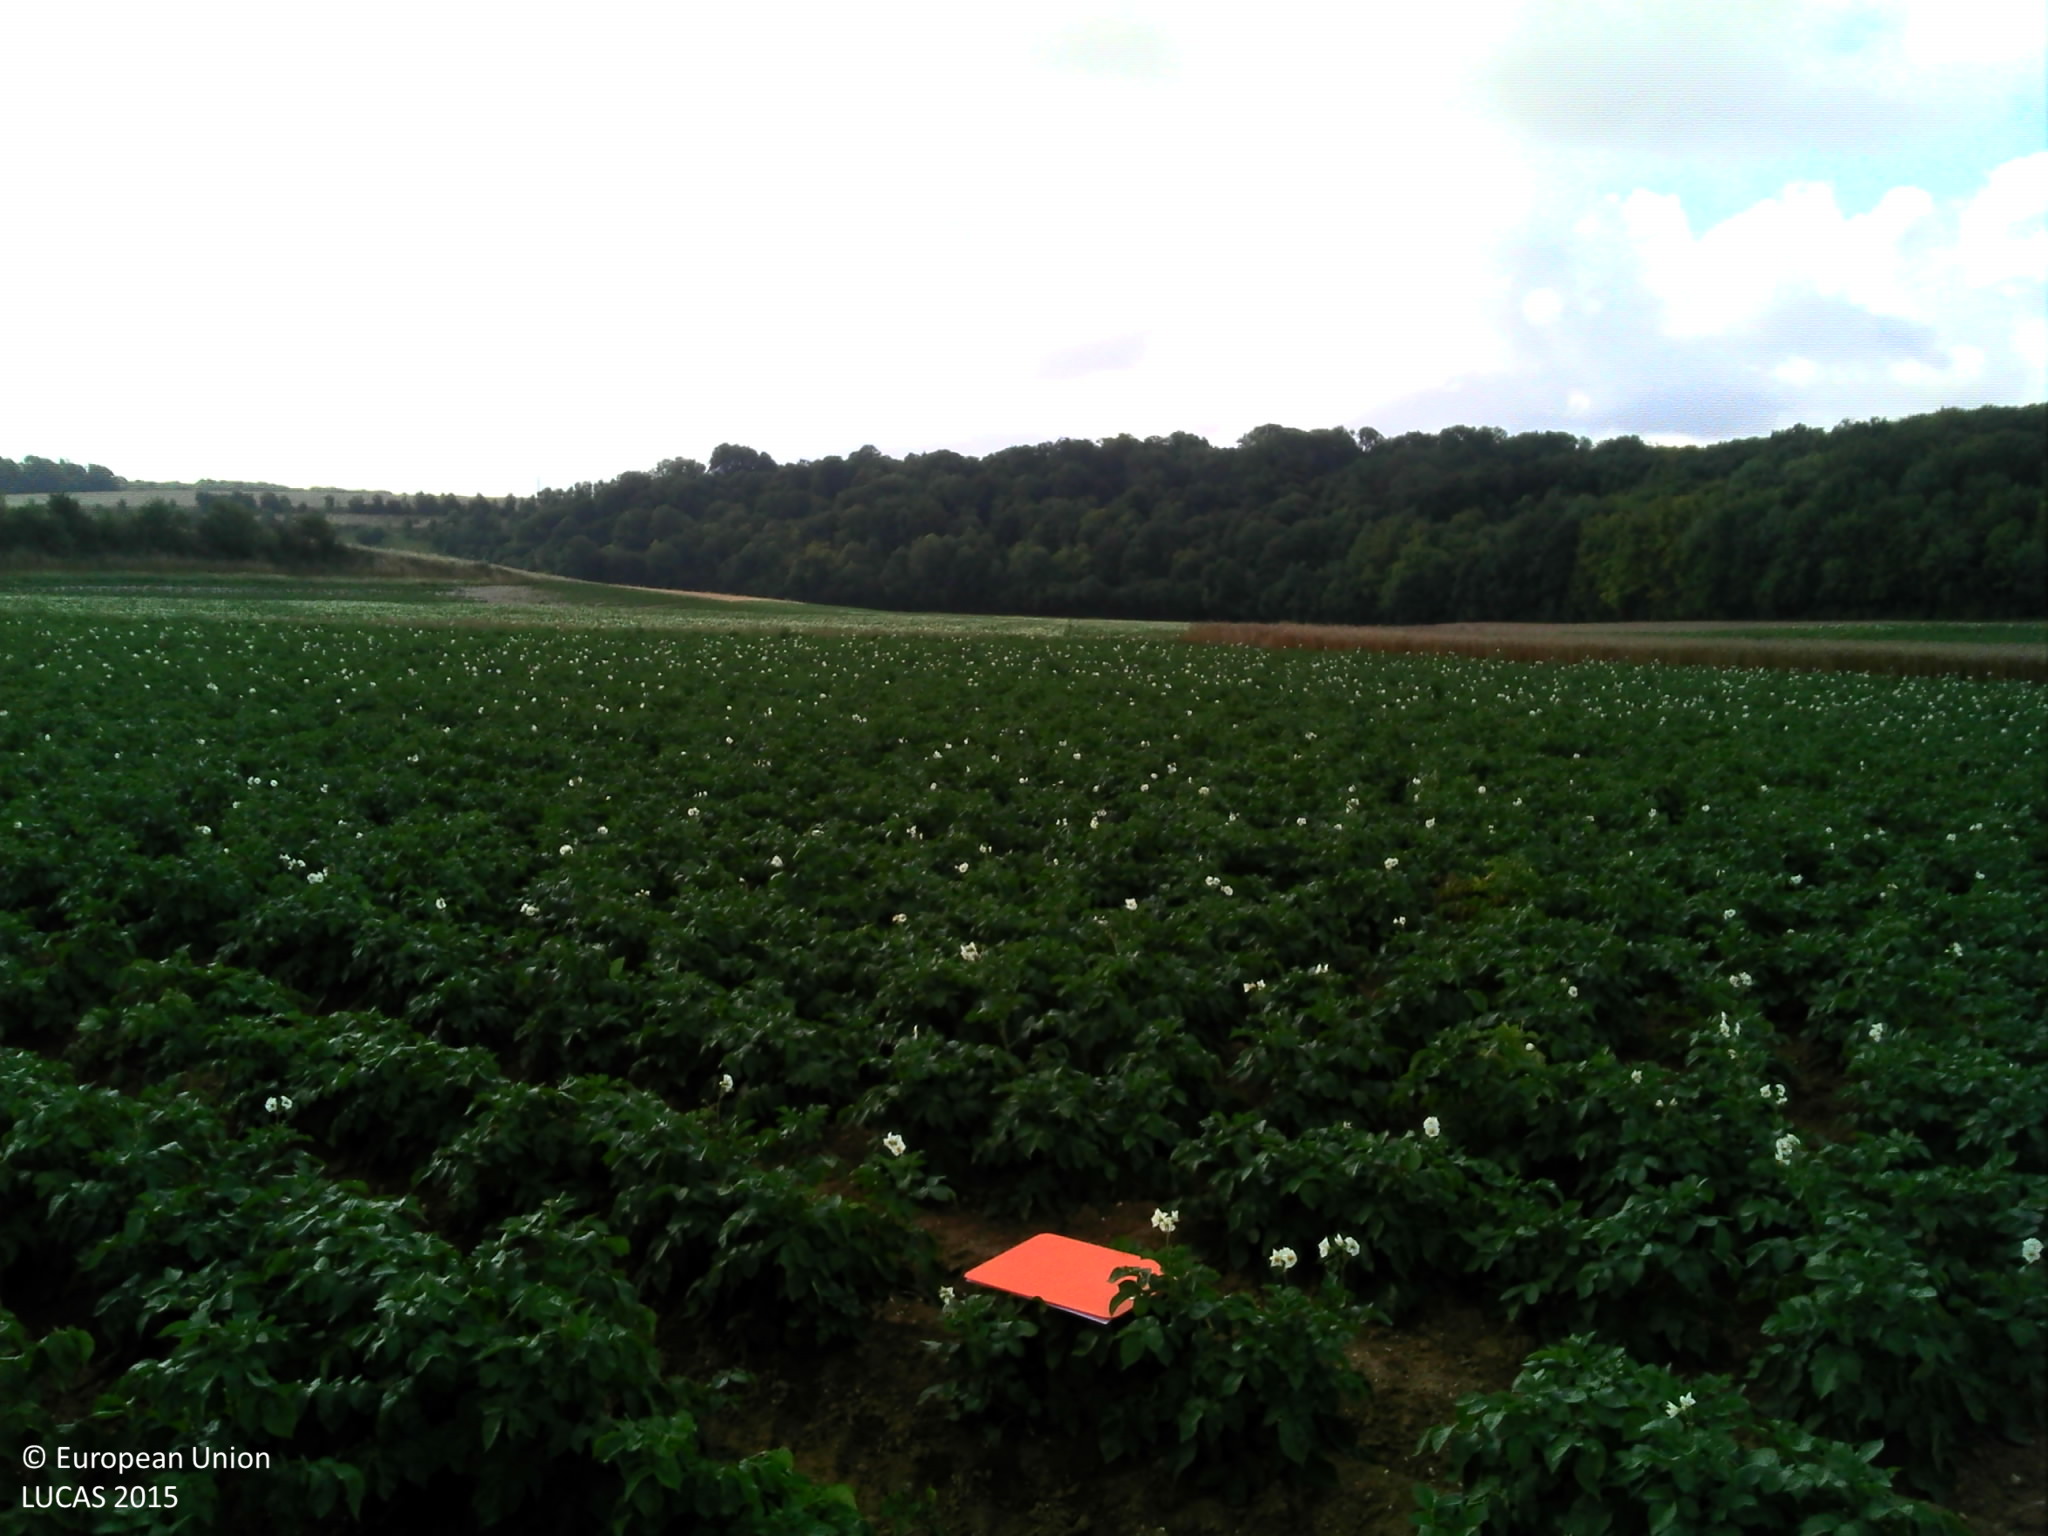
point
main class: Cropland
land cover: Potatoes
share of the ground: > 75 %
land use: Agriculture (excluding fallow land and kitchen gardens)
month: July
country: FR
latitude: 50.0410
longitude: 2.4332
